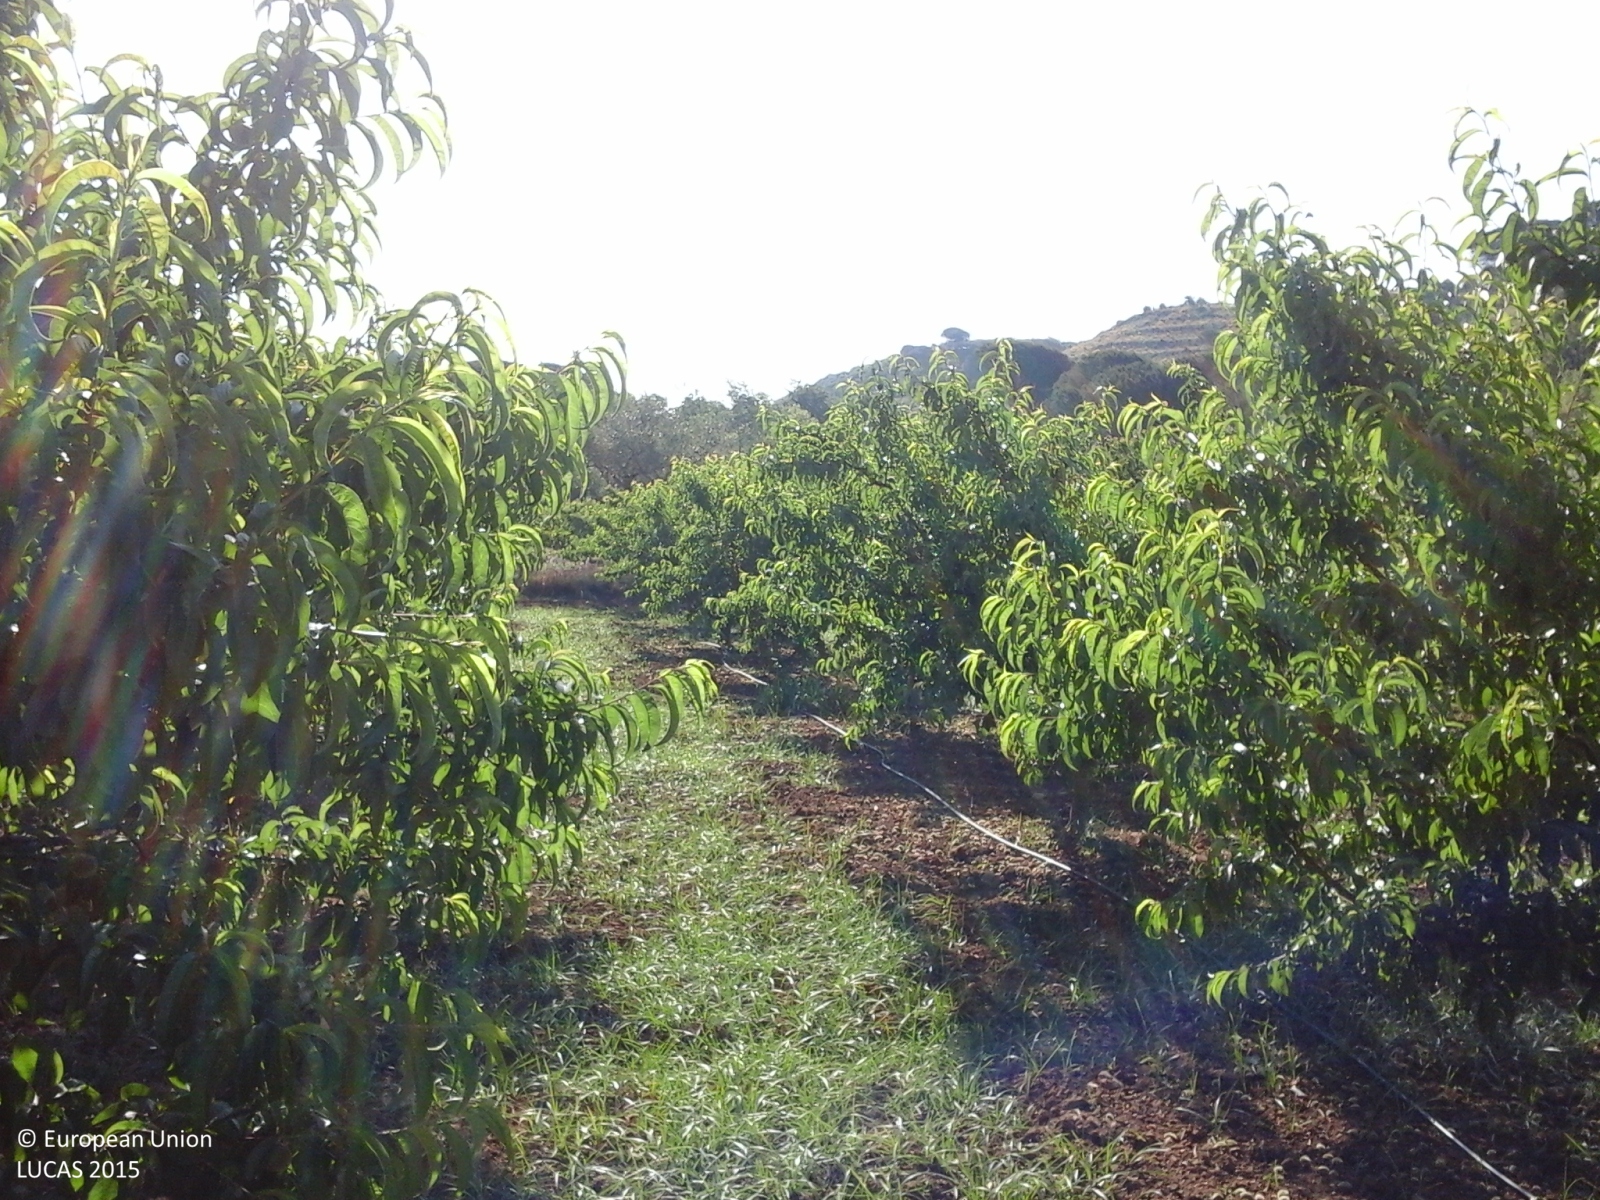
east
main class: Cropland
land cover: Other fruit trees and berries
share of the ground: 25 - 50 %
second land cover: Other bare soil
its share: > 75 %
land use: Agriculture (excluding fallow land and kitchen gardens)
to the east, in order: Other fruit trees and berries; Other bare soil; Grass margins; Other fruit trees and berries; Grass margins; Other fruit trees and berries; Olive groves; Other fruit trees and berries; Other mixed woodland; Inland fresh running water; Other mixed woodland
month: June
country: IT
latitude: 37.3536
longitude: 14.4260
